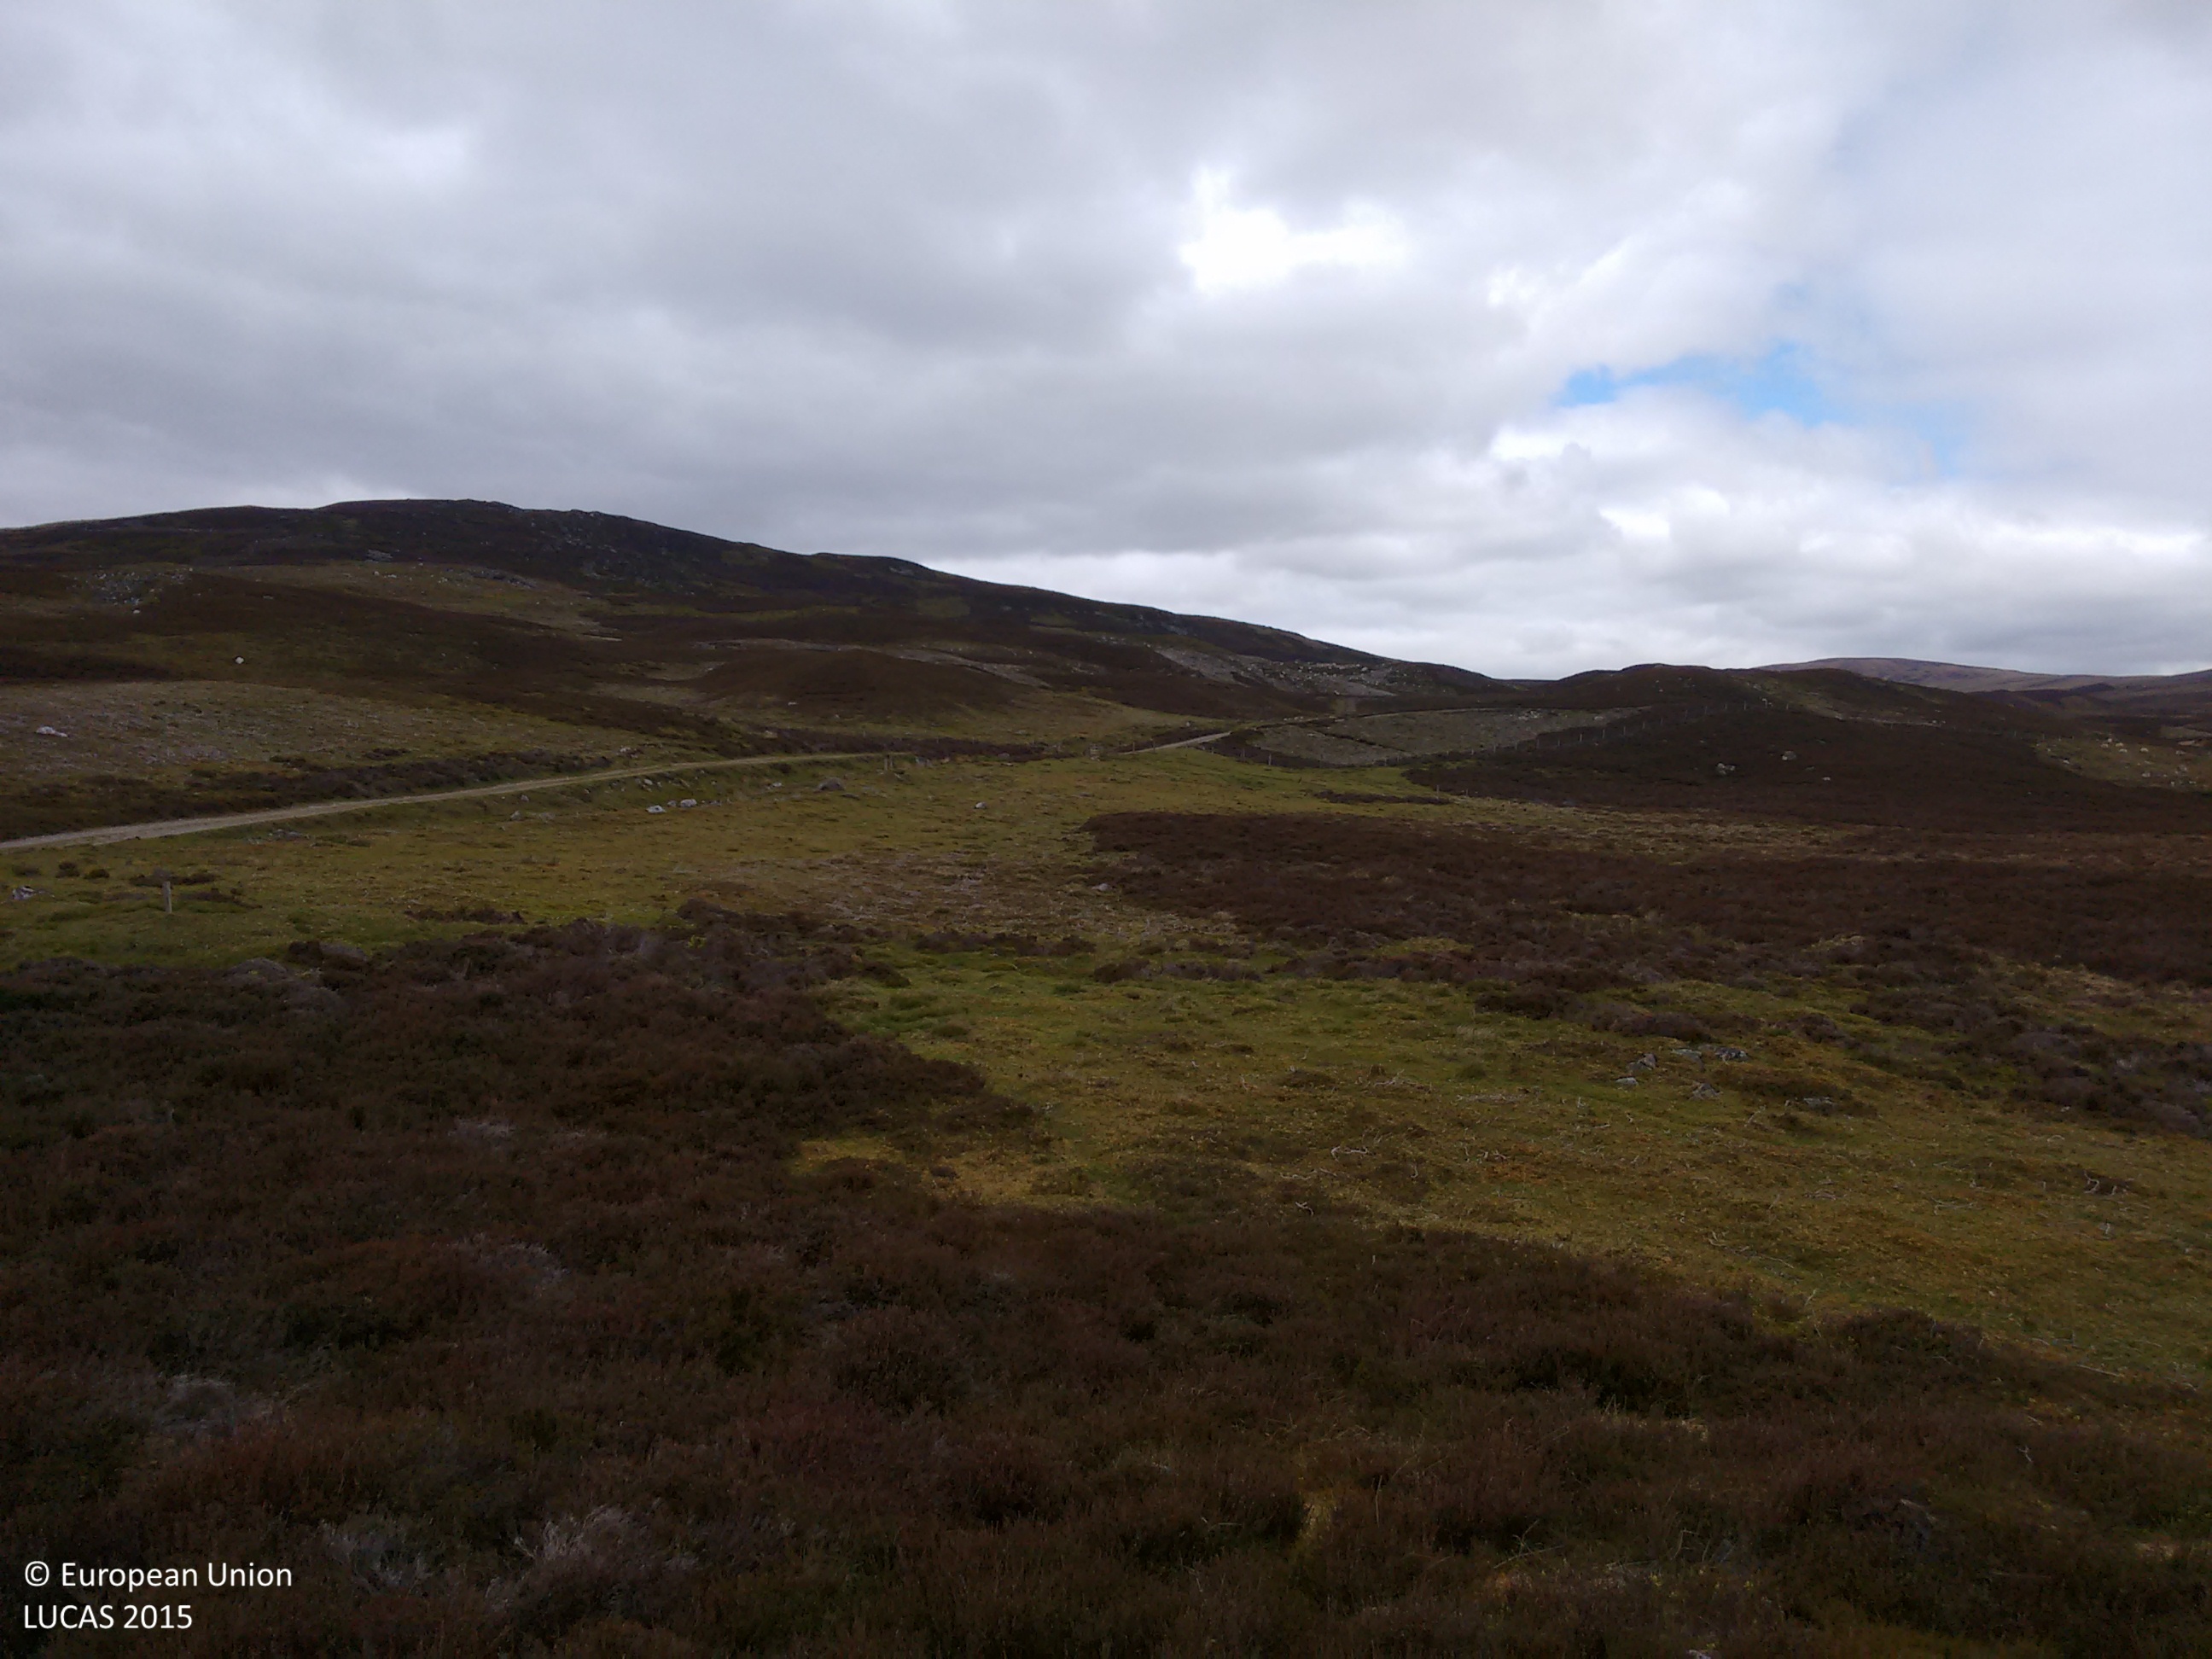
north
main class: Shrubland
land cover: Shrubland without tree cover
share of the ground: > 75 %
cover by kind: shrubs 90 %, lichens and mosses 5 %
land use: Agriculture (excluding fallow land and kitchen gardens)
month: June
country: GB
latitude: 57.1083
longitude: -4.0683
